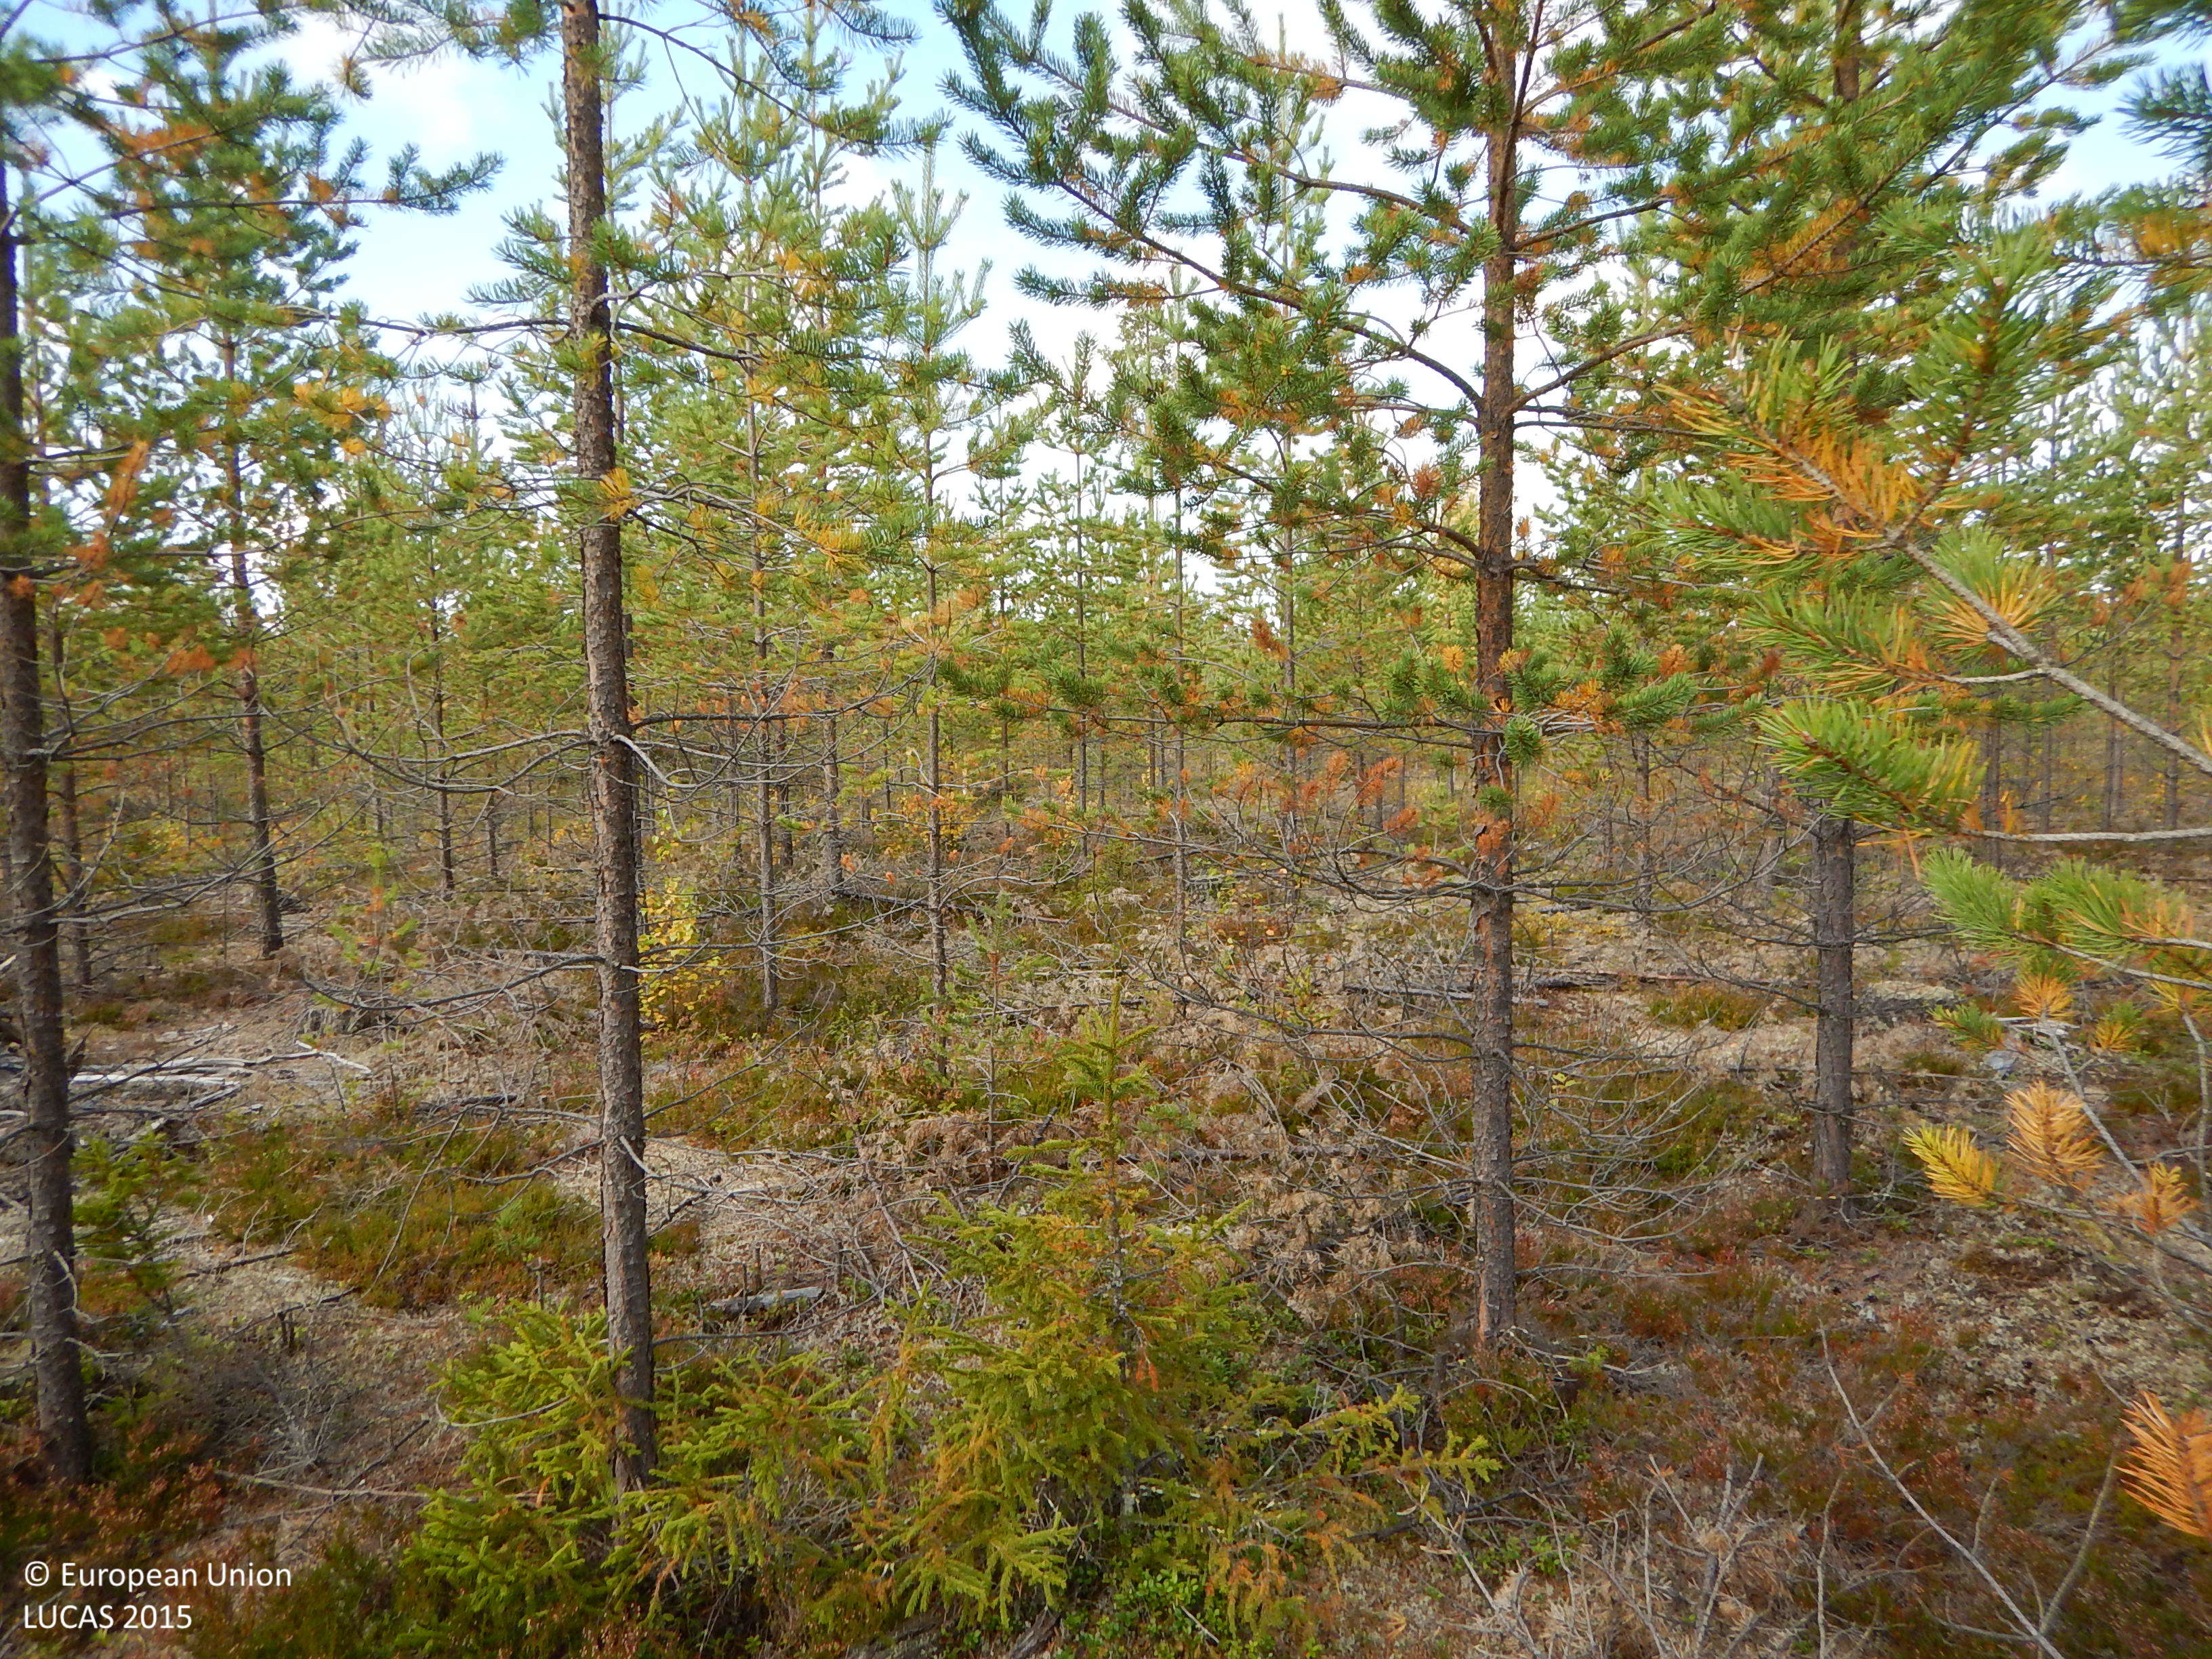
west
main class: Woodland
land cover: Pine dominated coniferous woodland
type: boreal forest
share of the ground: 25 - 50 %
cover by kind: coniferous forest trees 40 %, lichens and mosses 25 %, unconsolidated bare surface 15 %, herbaceous plants 10 %, broadleaved forest trees 5 %, shrubs 5 %
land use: Forestry
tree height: < 5 m
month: September
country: SE
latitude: 64.8150
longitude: 20.2292
